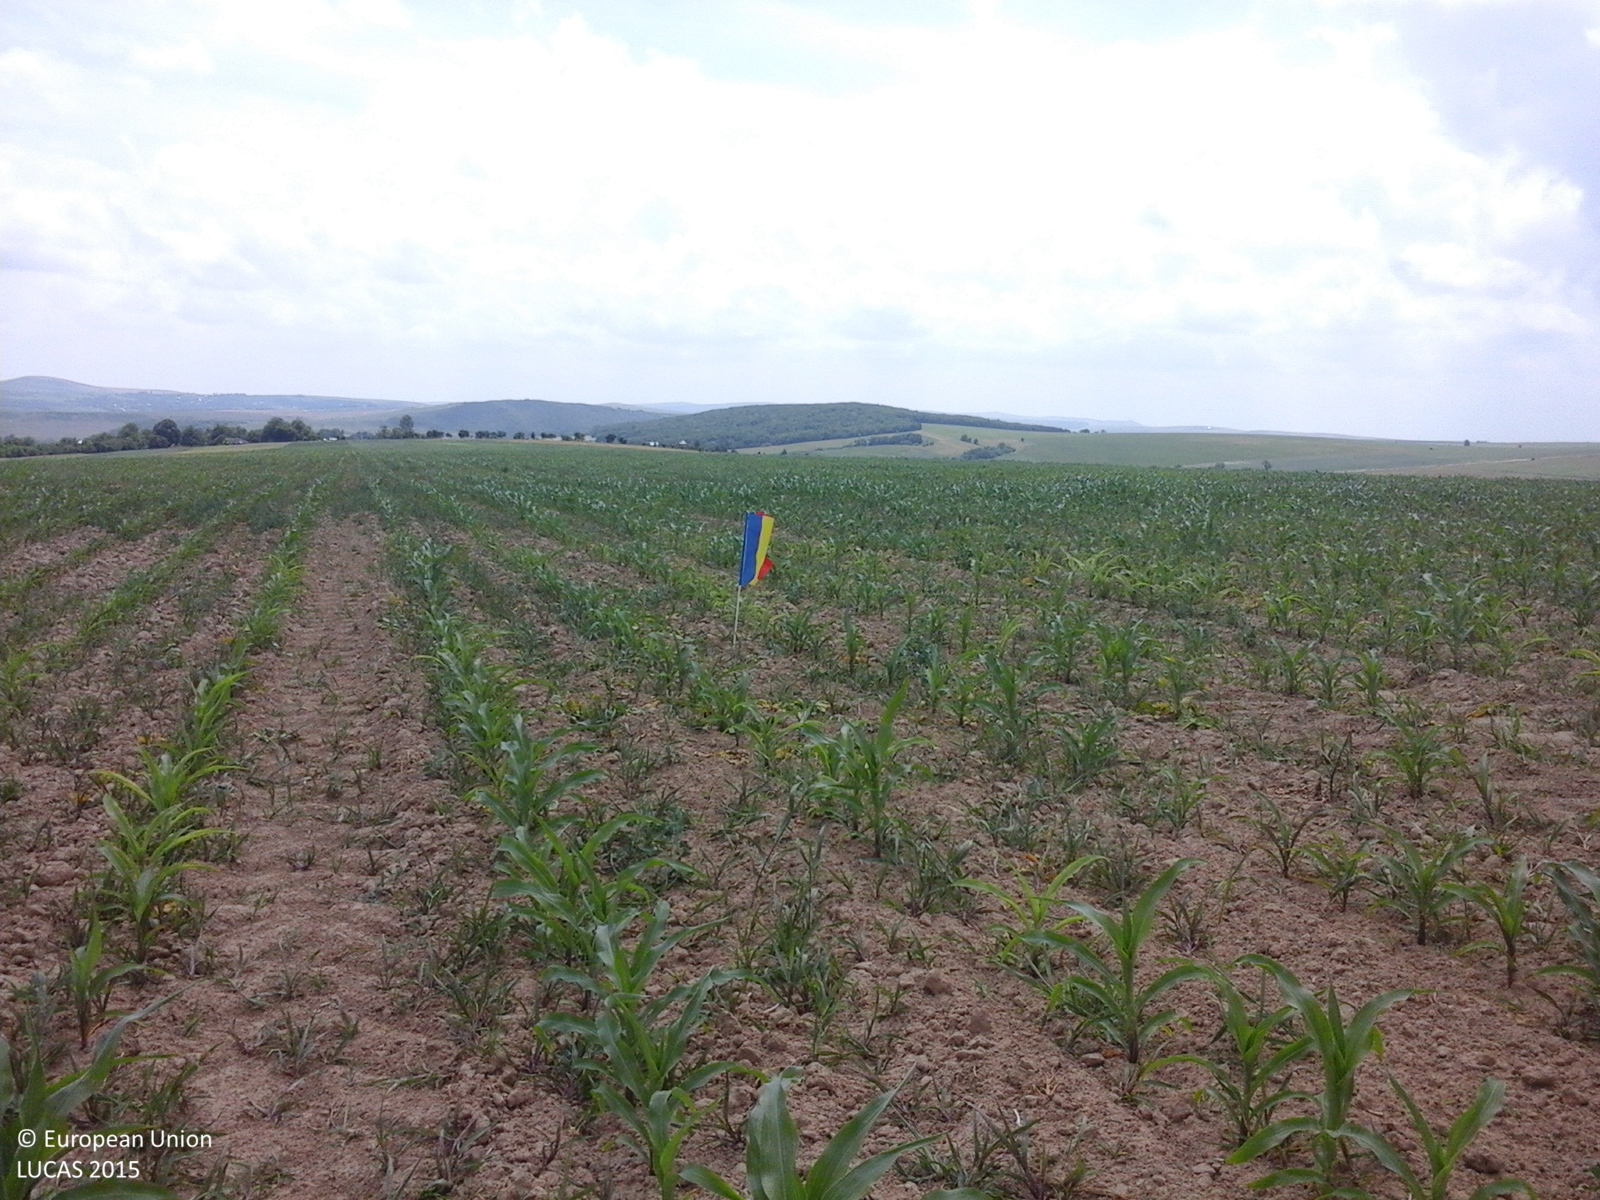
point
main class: Cropland
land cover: Maize
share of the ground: 10 - 25 %
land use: Agriculture (excluding fallow land and kitchen gardens)
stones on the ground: < 10 %
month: June
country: RO
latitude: 47.0480
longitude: 26.5812
